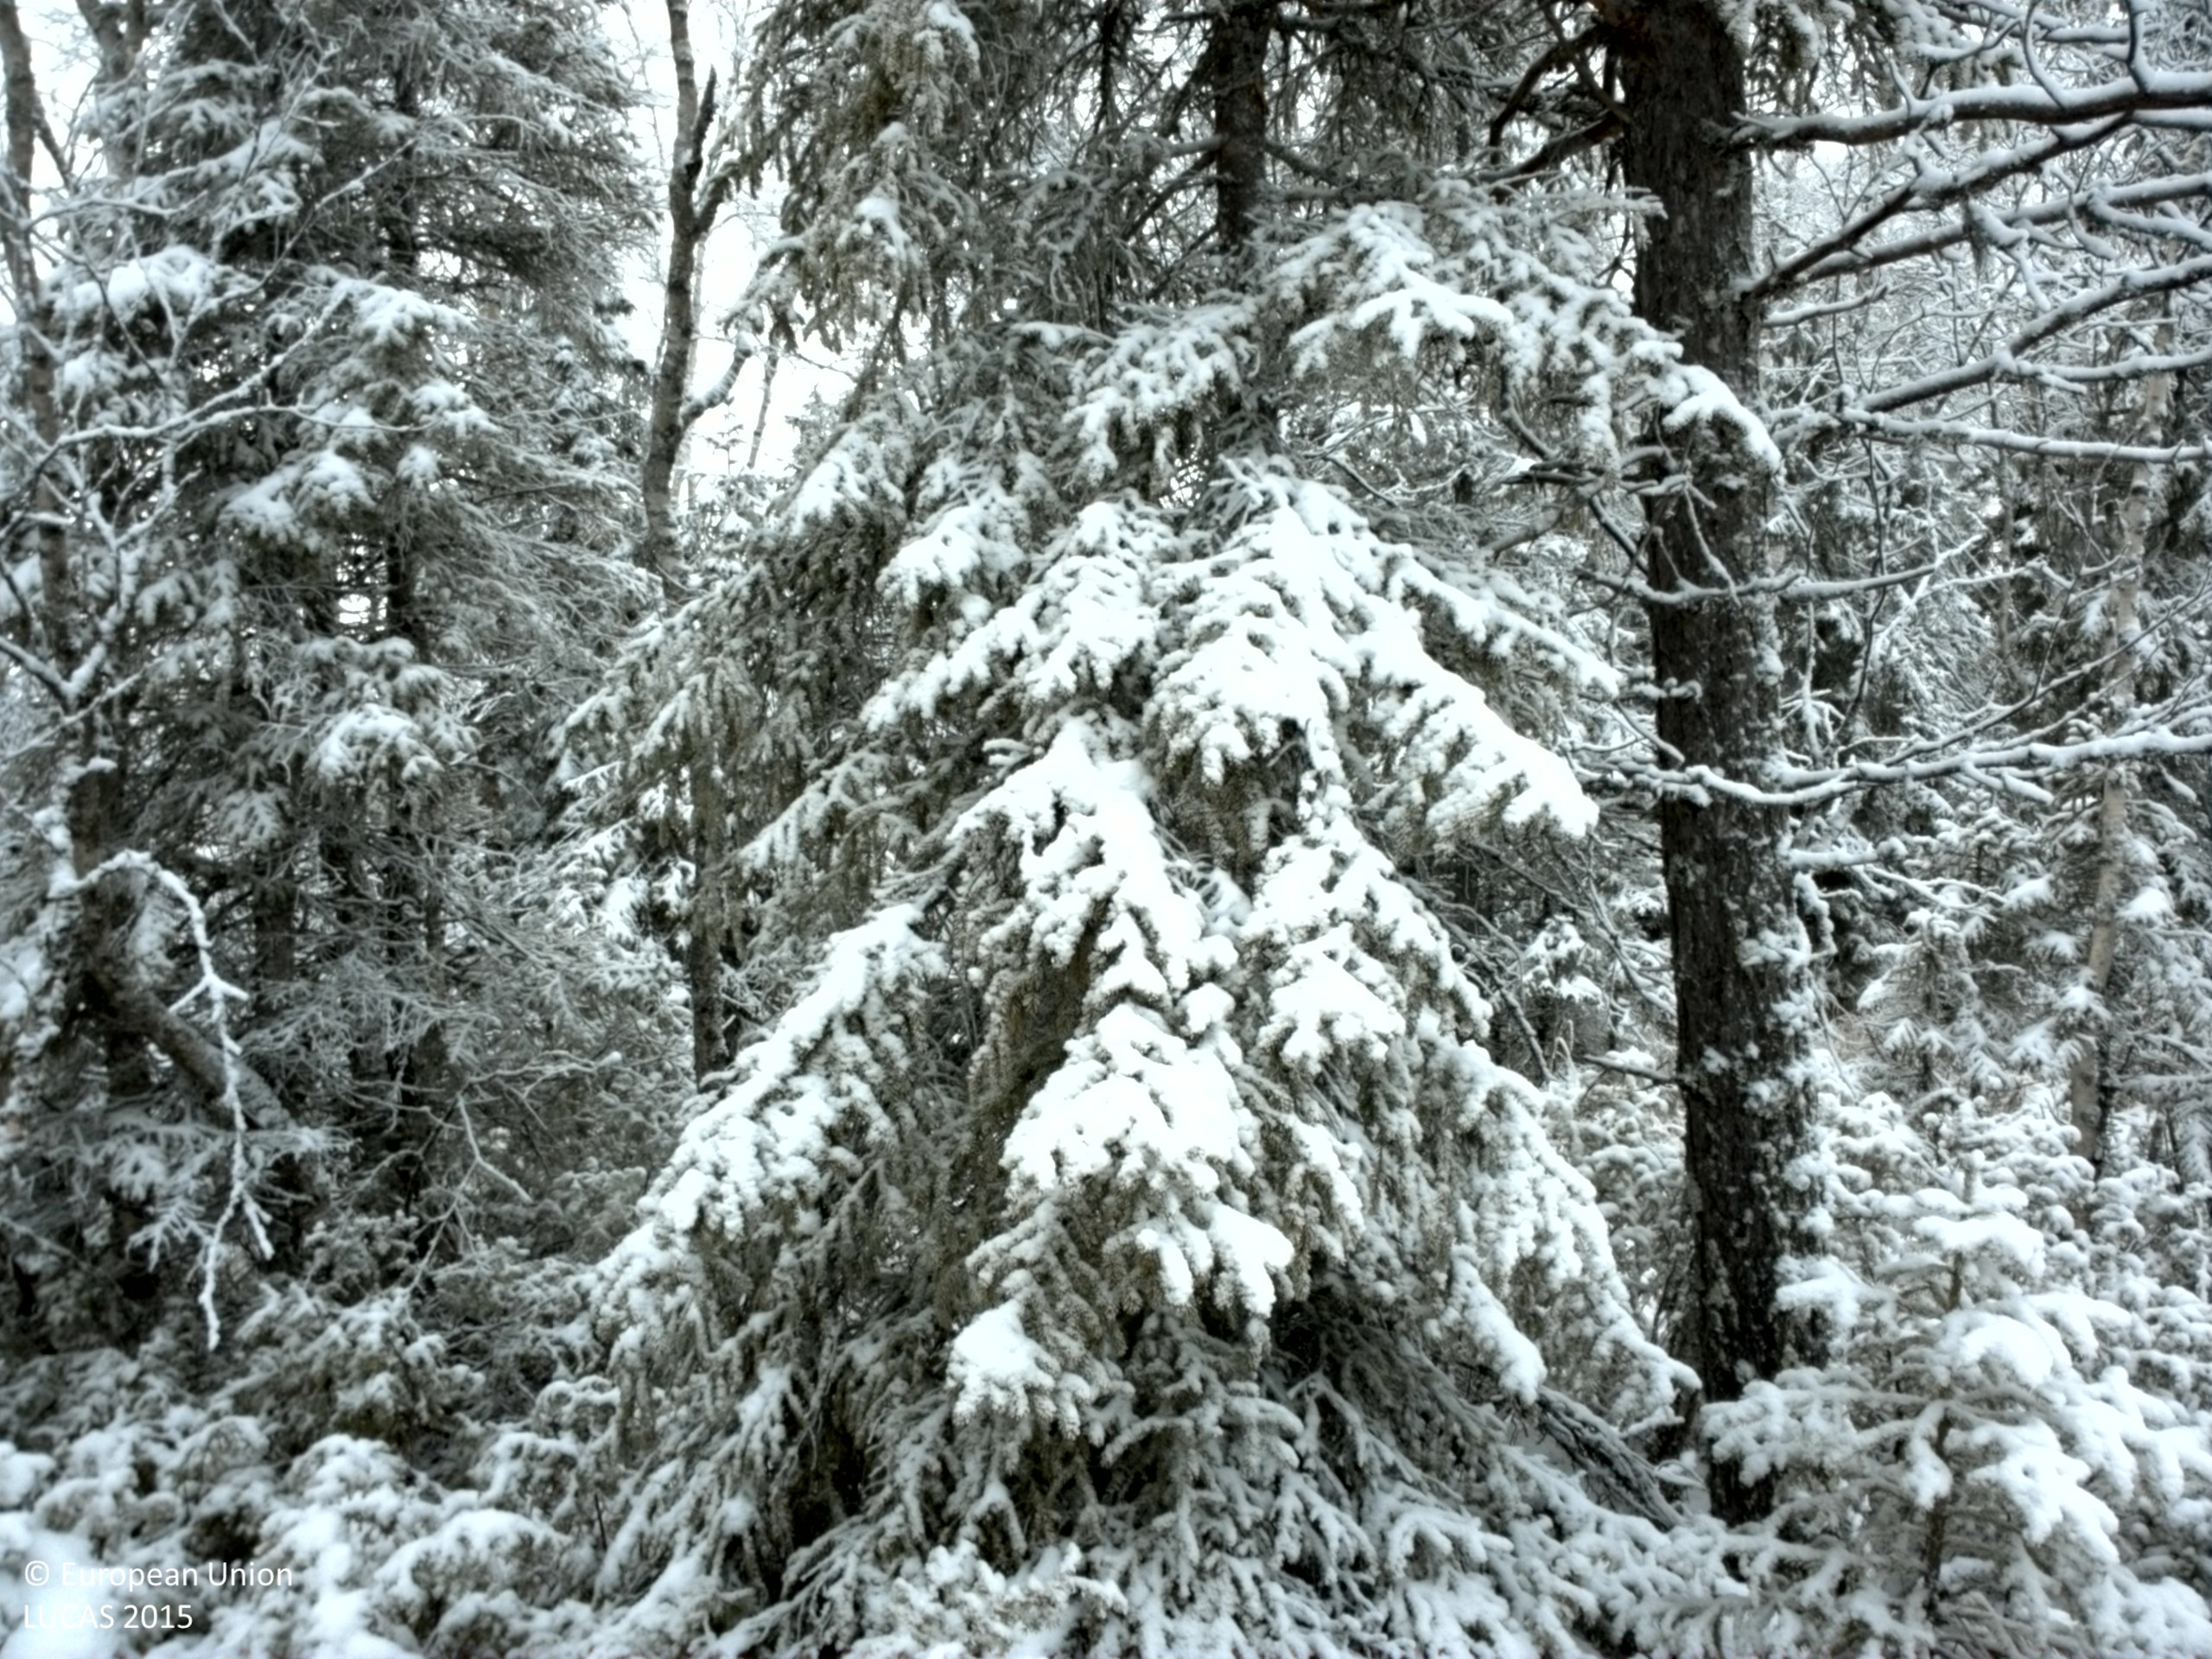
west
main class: Woodland
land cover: Spruce dominated mixed woodland
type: mire and swamp forests
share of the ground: 25 - 50 %
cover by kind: herbaceous plants 40 %, lichens and mosses 20 %, coniferous forest trees 15 %, shrubs 15 %, broadleaved forest trees 10 %
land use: Forestry
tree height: < 5 m
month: November
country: SE
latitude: 63.7319
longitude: 15.2604
